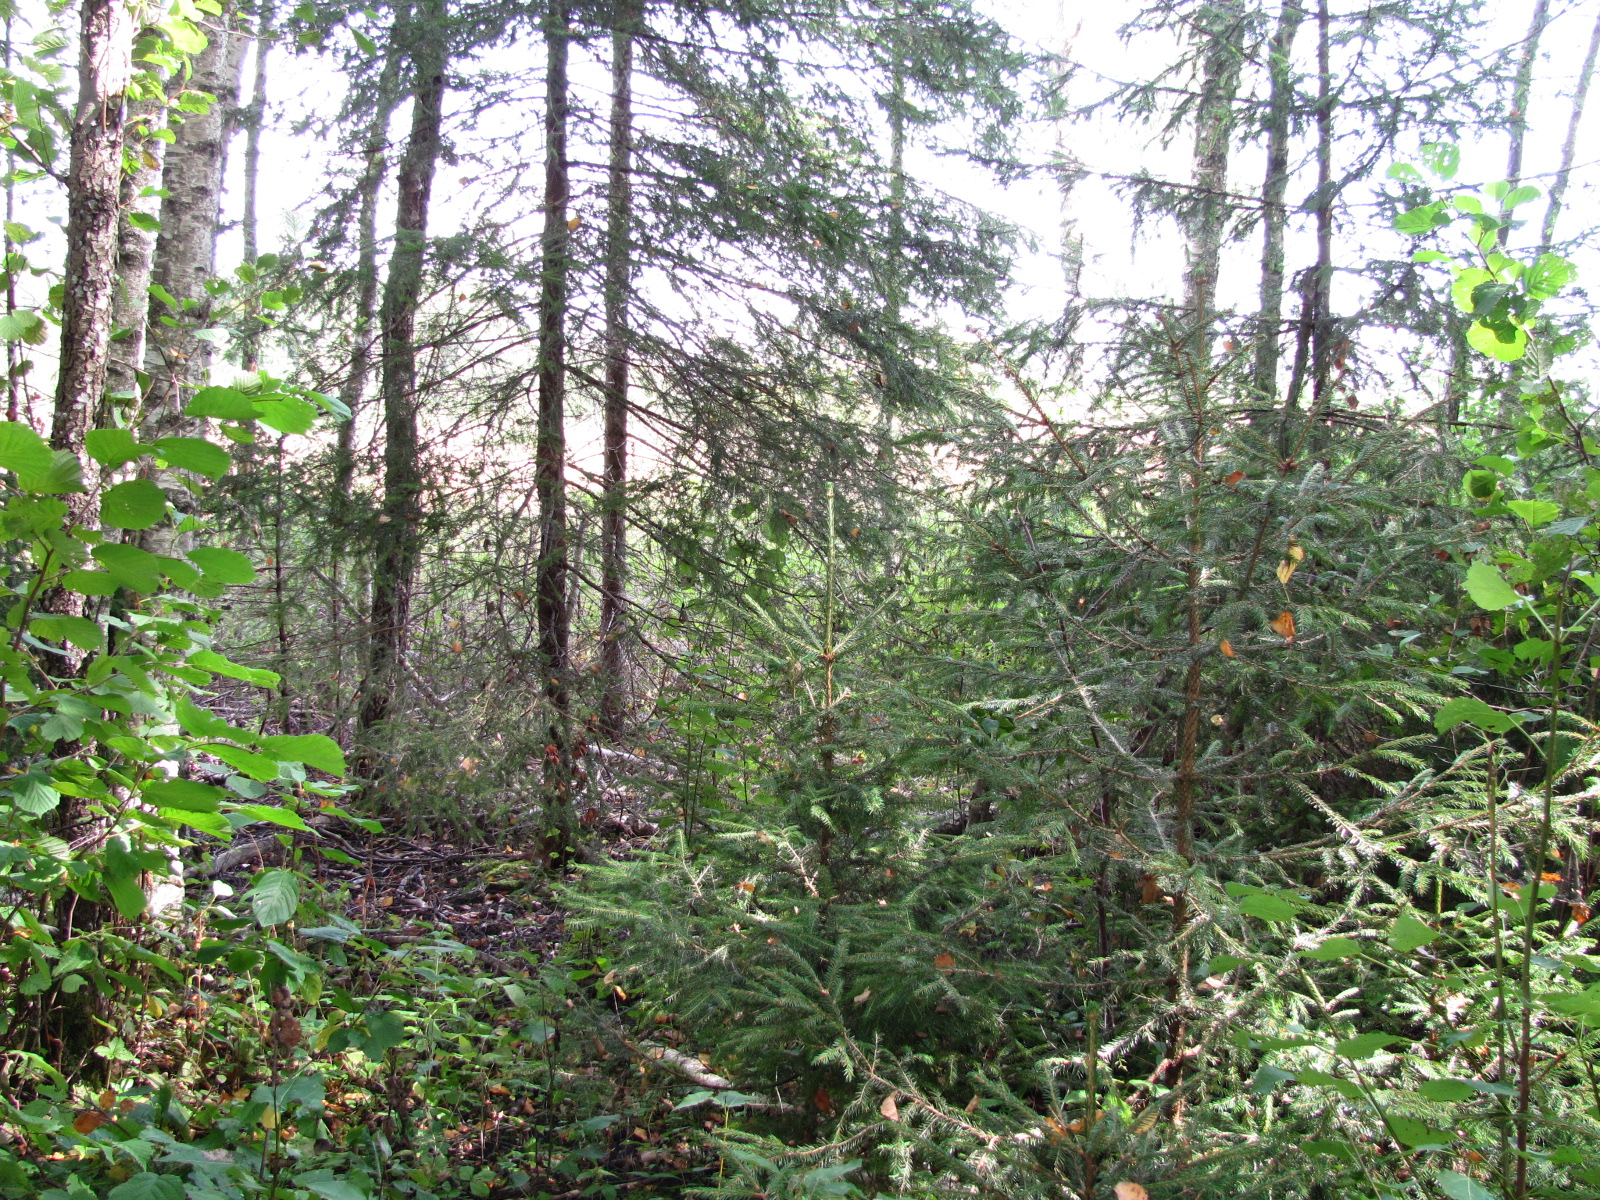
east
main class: Woodland
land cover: Spruce dominated mixed woodland
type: hemiboreal forest and nemoral coniferous forest and mixed broadleaved-coniferous forest
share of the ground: > 75 %
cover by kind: broadleaved forest trees 50 %, coniferous forest trees 30 %, herbaceous plants 15 %, lichens and mosses 5 %
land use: Forestry
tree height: > 5 m
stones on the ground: < 10 %
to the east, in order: Spruce dominated mixed woodland; Shrubland with sparse tree cover; Ditches and canals; Grassland without tree/shrub cover; Ditches and canals; Broadleaved woodland
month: August
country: LV
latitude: 56.9203
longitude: 25.2414
